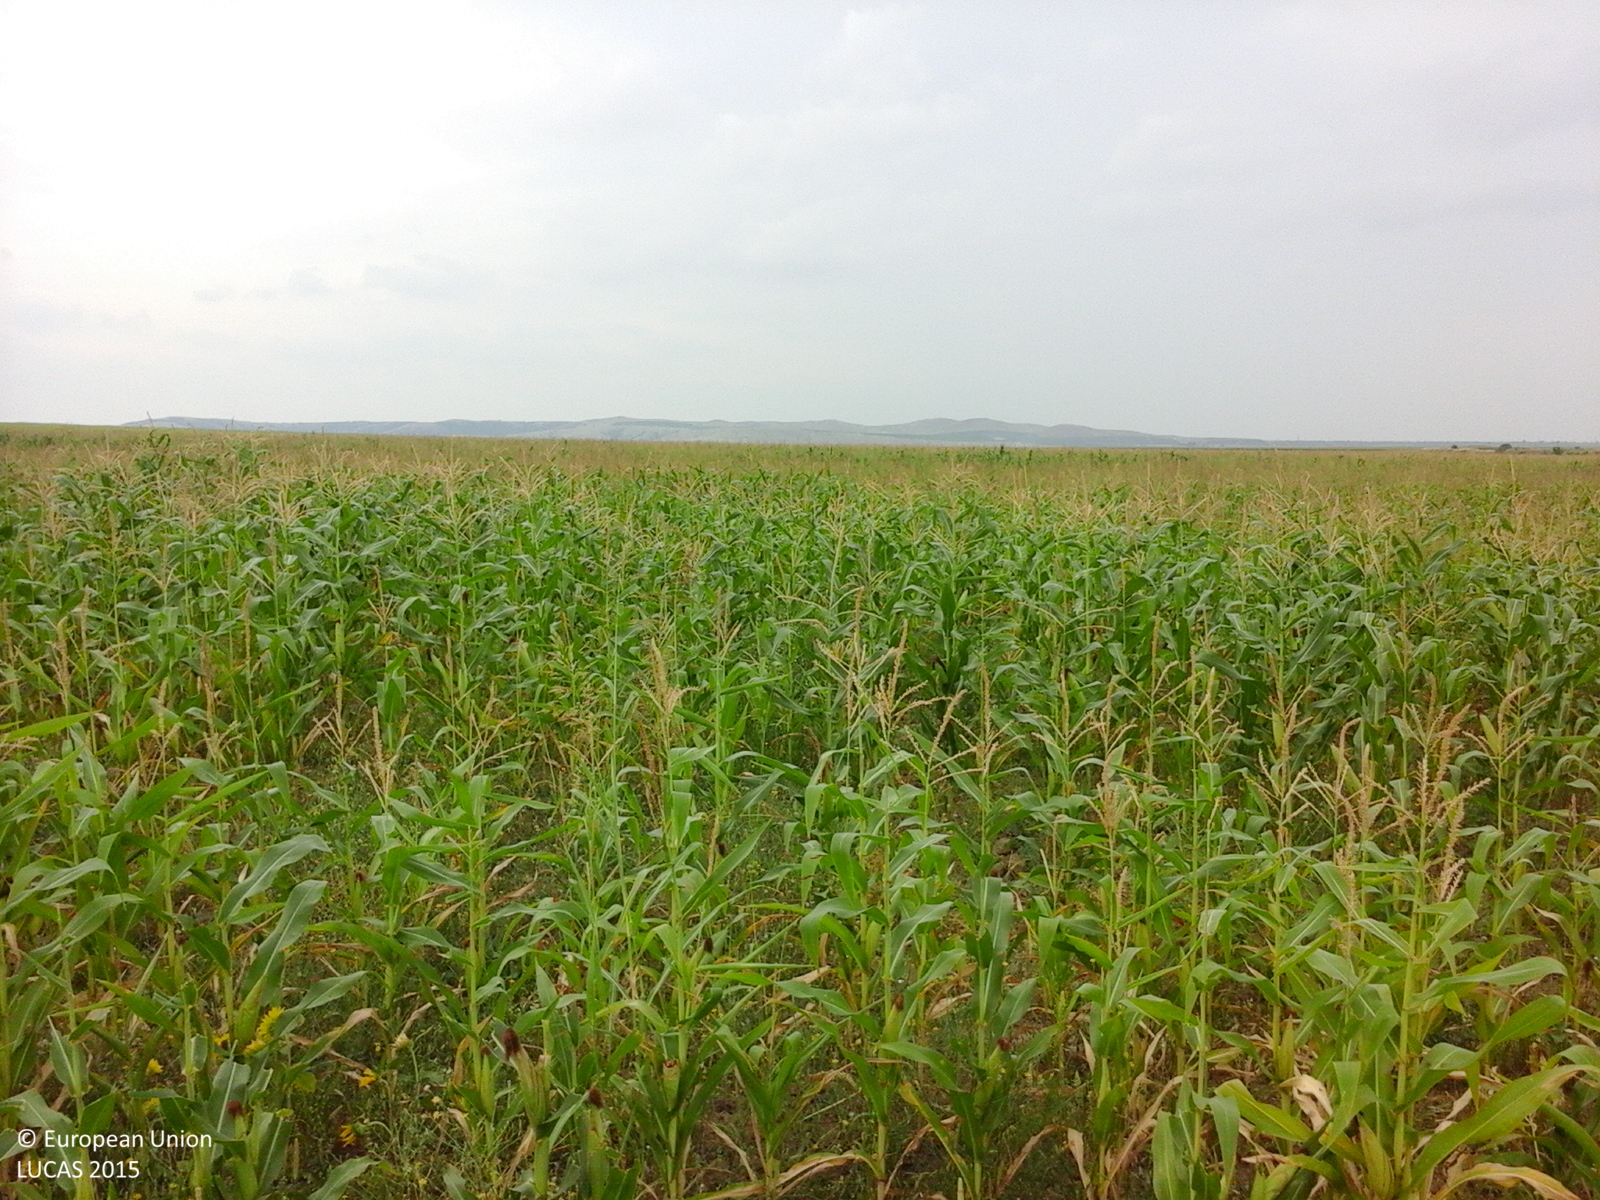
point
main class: Cropland
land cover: Maize
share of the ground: > 75 %
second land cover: Spontaneously vegetated surfaces
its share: > 75 %
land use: Agriculture (excluding fallow land and kitchen gardens)
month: July
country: RO
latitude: 44.9382
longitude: 28.2019
